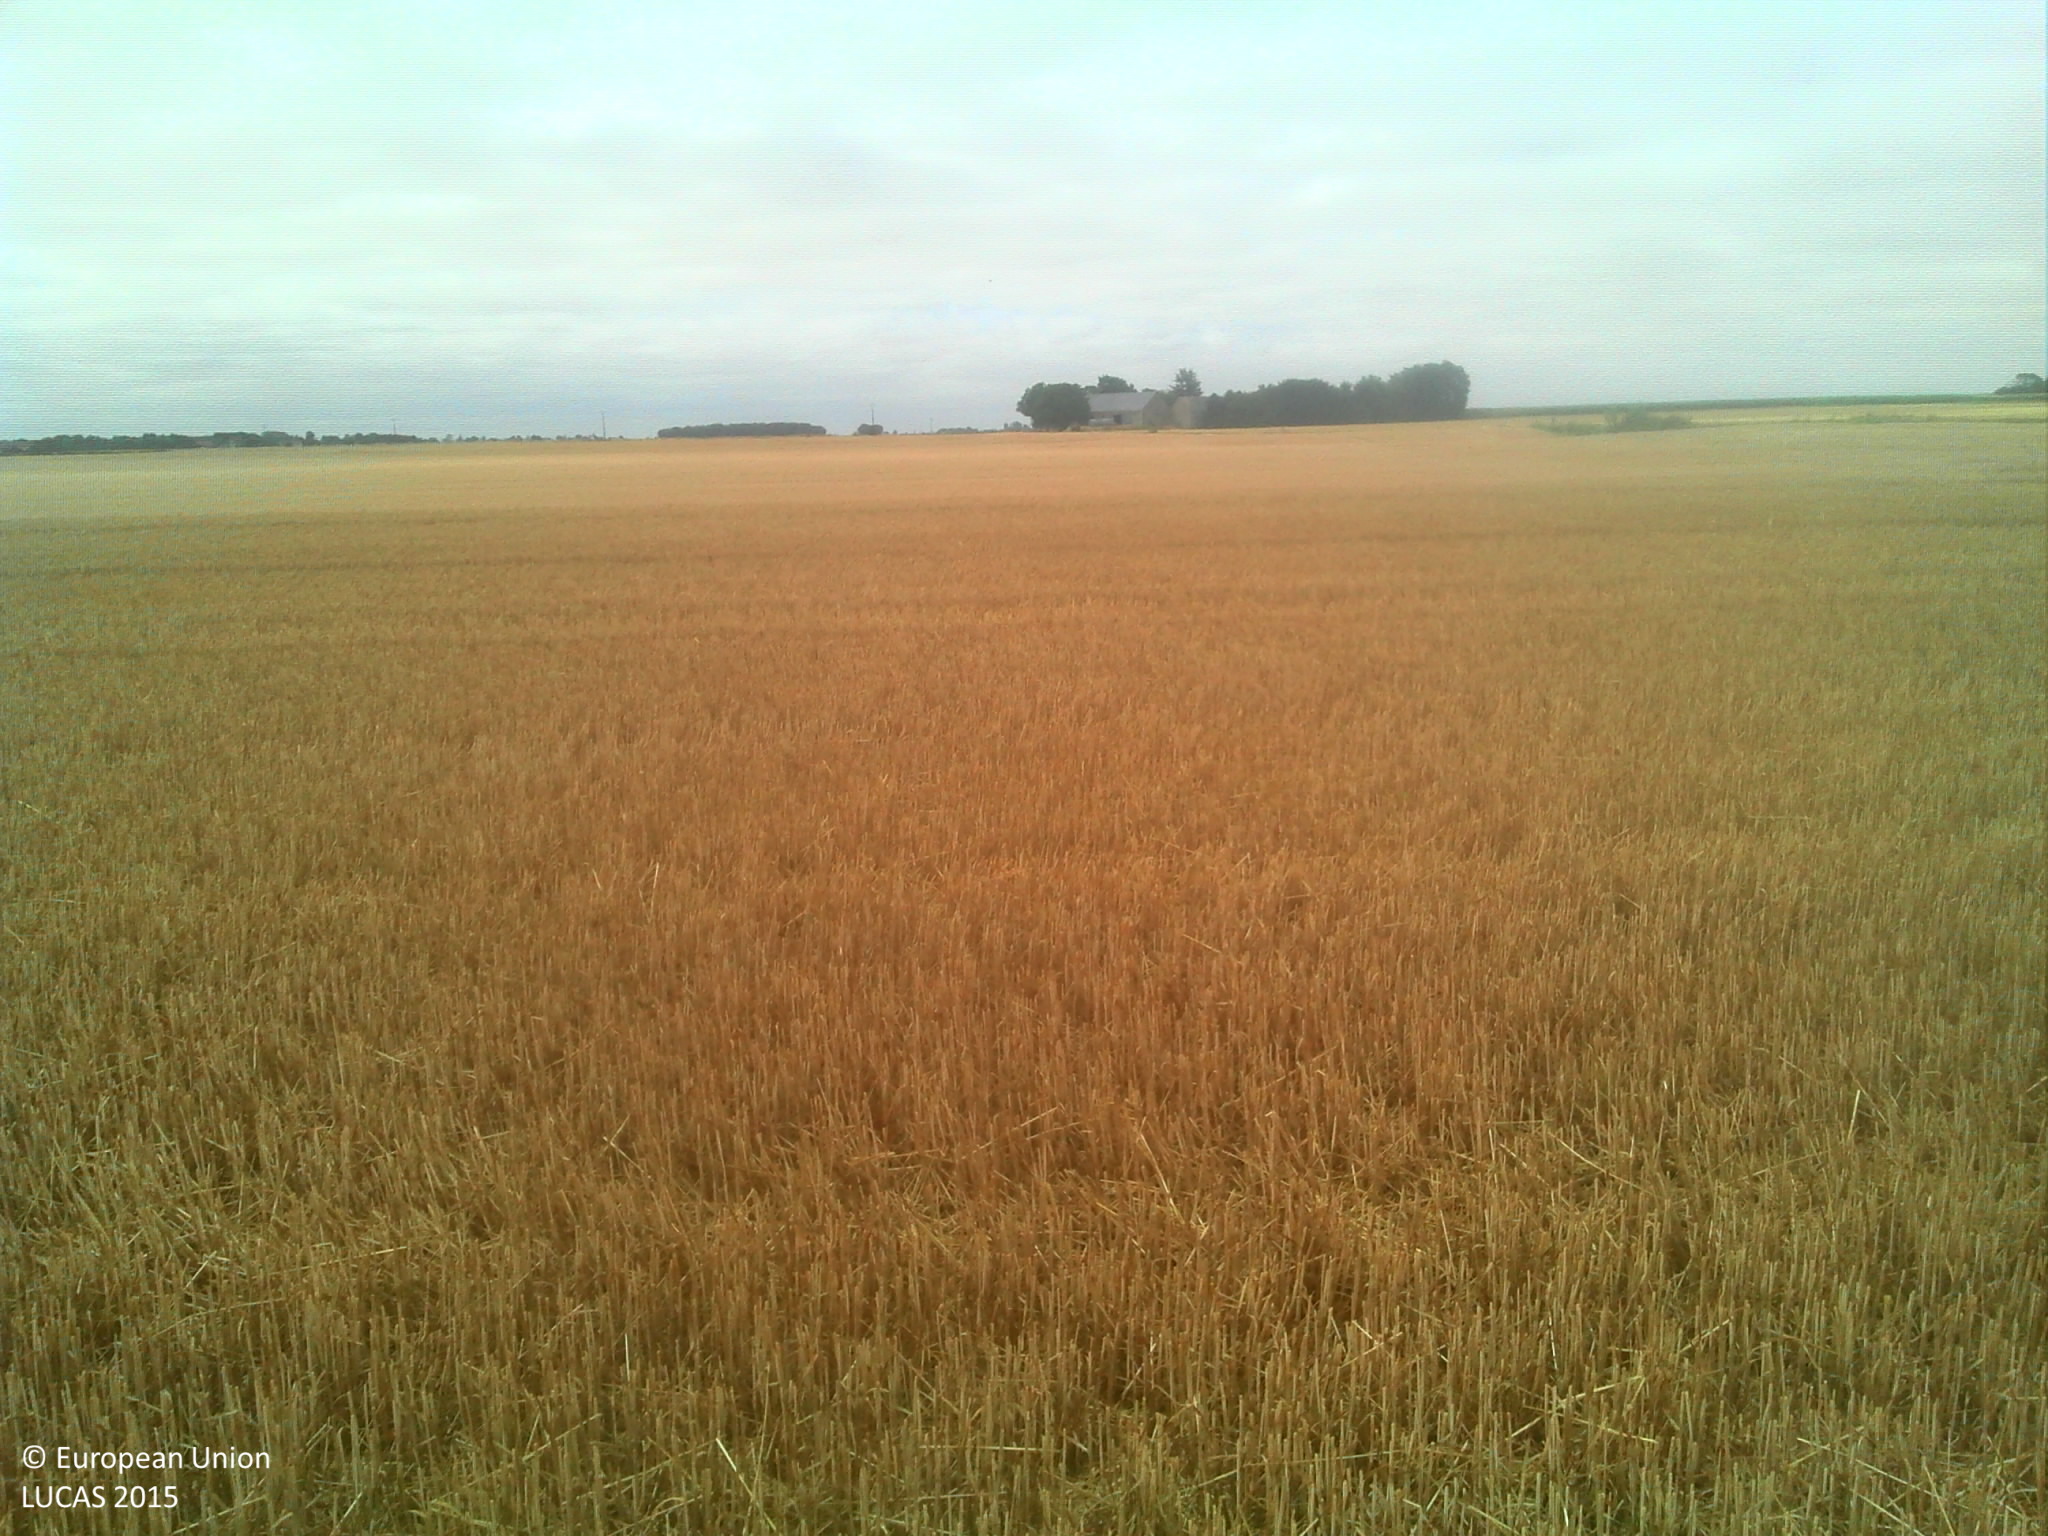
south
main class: Cropland
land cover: Durum wheat
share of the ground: > 75 %
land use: Agriculture (excluding fallow land and kitchen gardens)
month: July
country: FR
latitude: 47.7881
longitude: 1.2941
